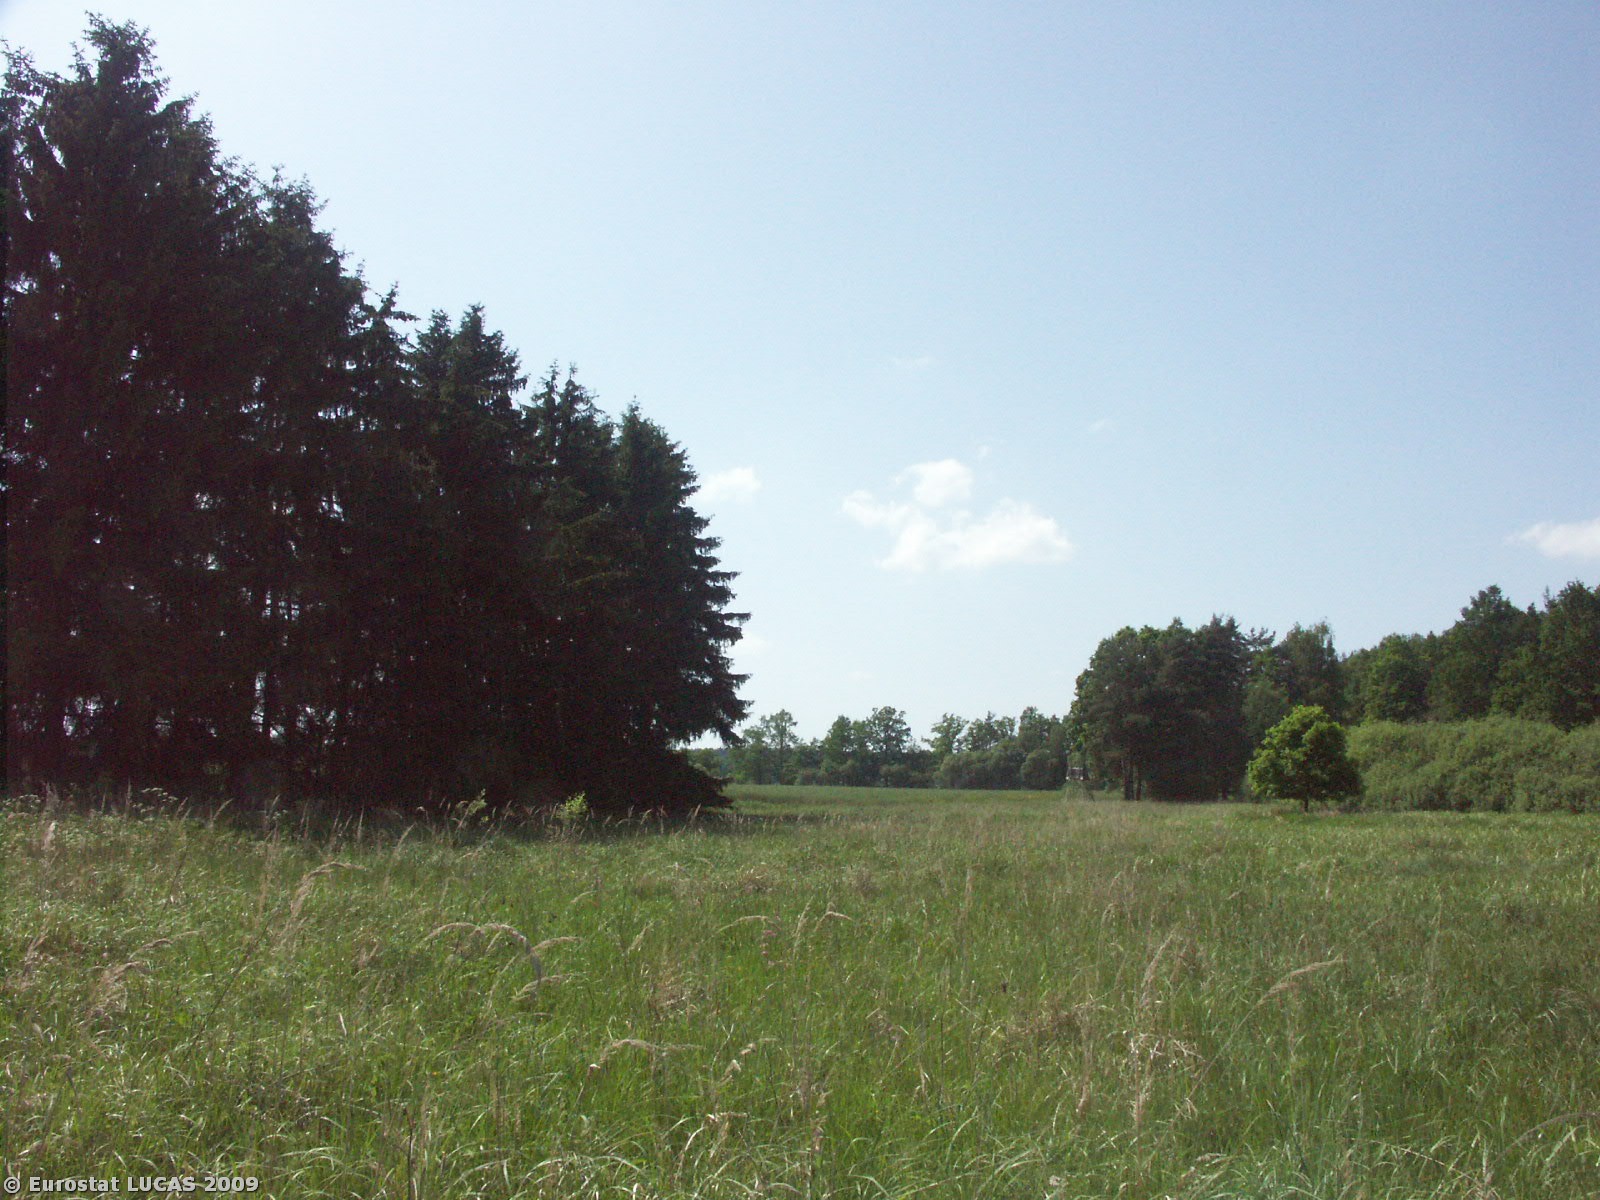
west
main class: Grassland
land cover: Grassland without tree/shrub cover
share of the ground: > 75 %
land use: Unused
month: May
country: CZ
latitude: 49.0450
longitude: 14.6394
